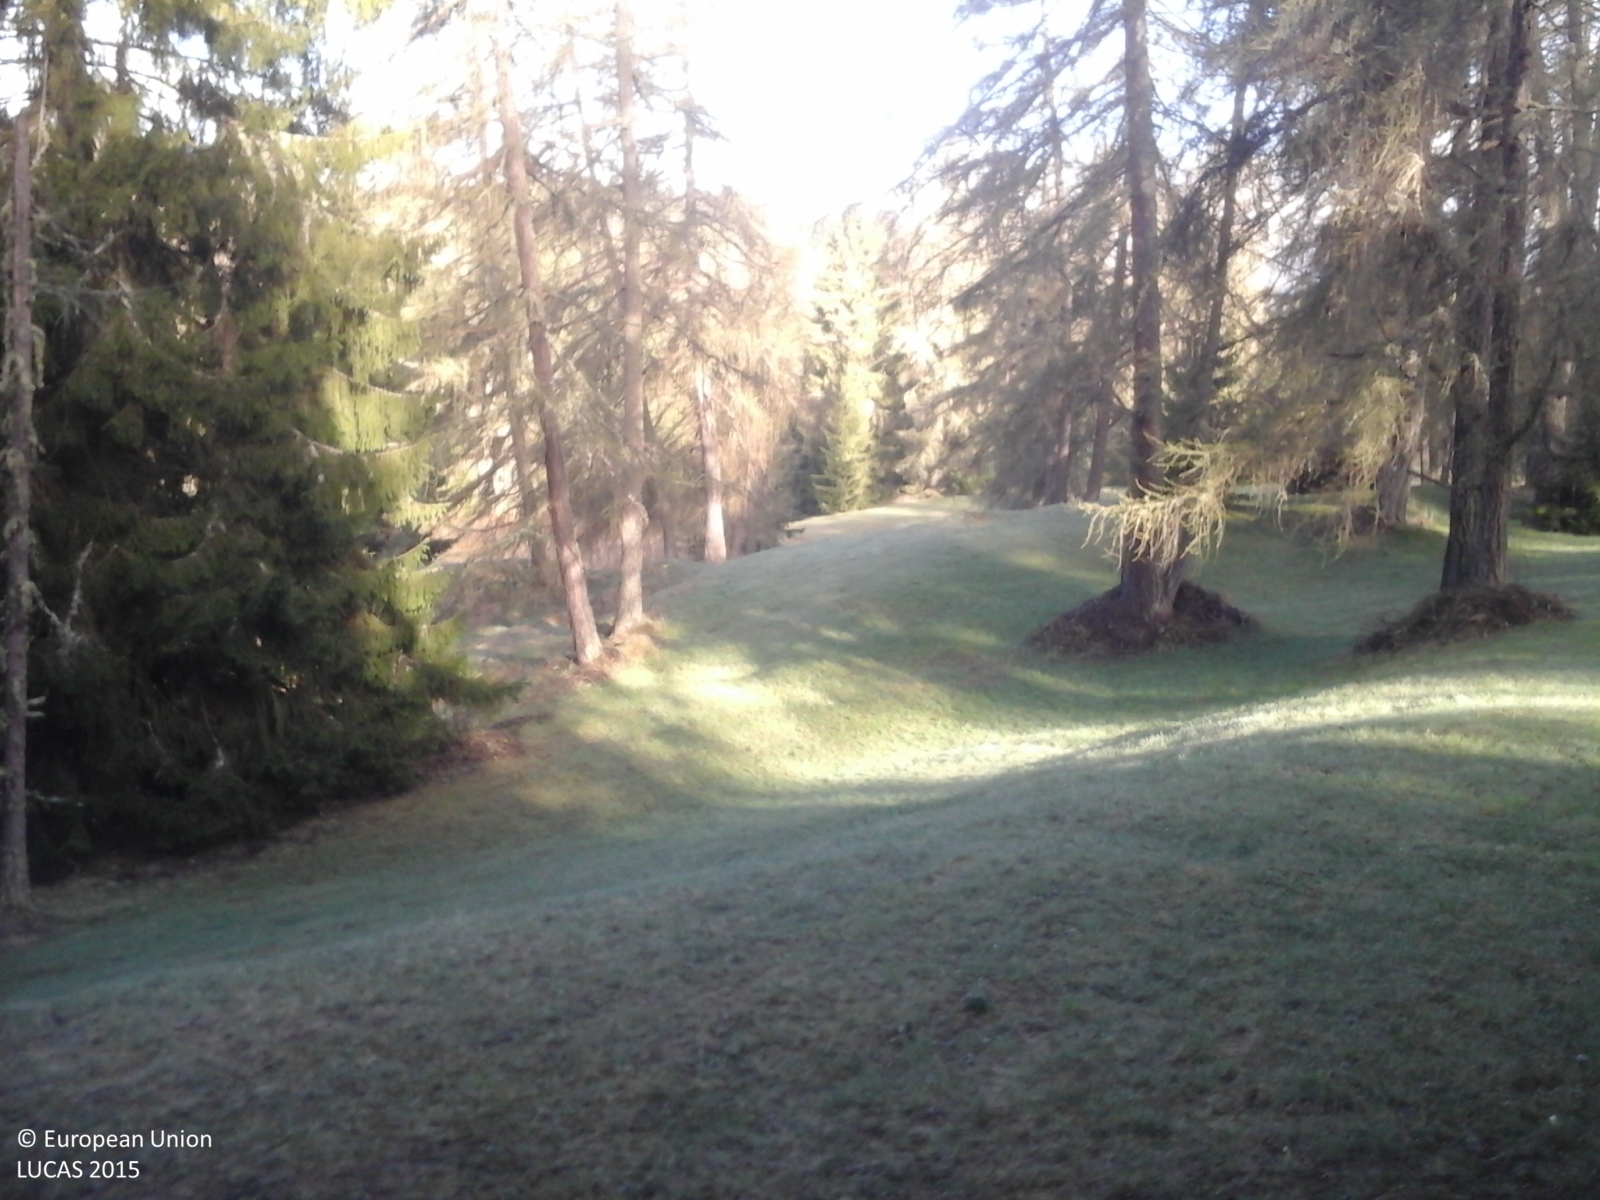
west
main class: Woodland
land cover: Other coniferous woodland
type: alpine coniferous forest
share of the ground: 25 - 50 %
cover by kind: coniferous forest trees 70 %, herbaceous plants 30 %
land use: Forestry
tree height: > 5 m
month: May
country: IT
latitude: 46.4347
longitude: 11.1828
